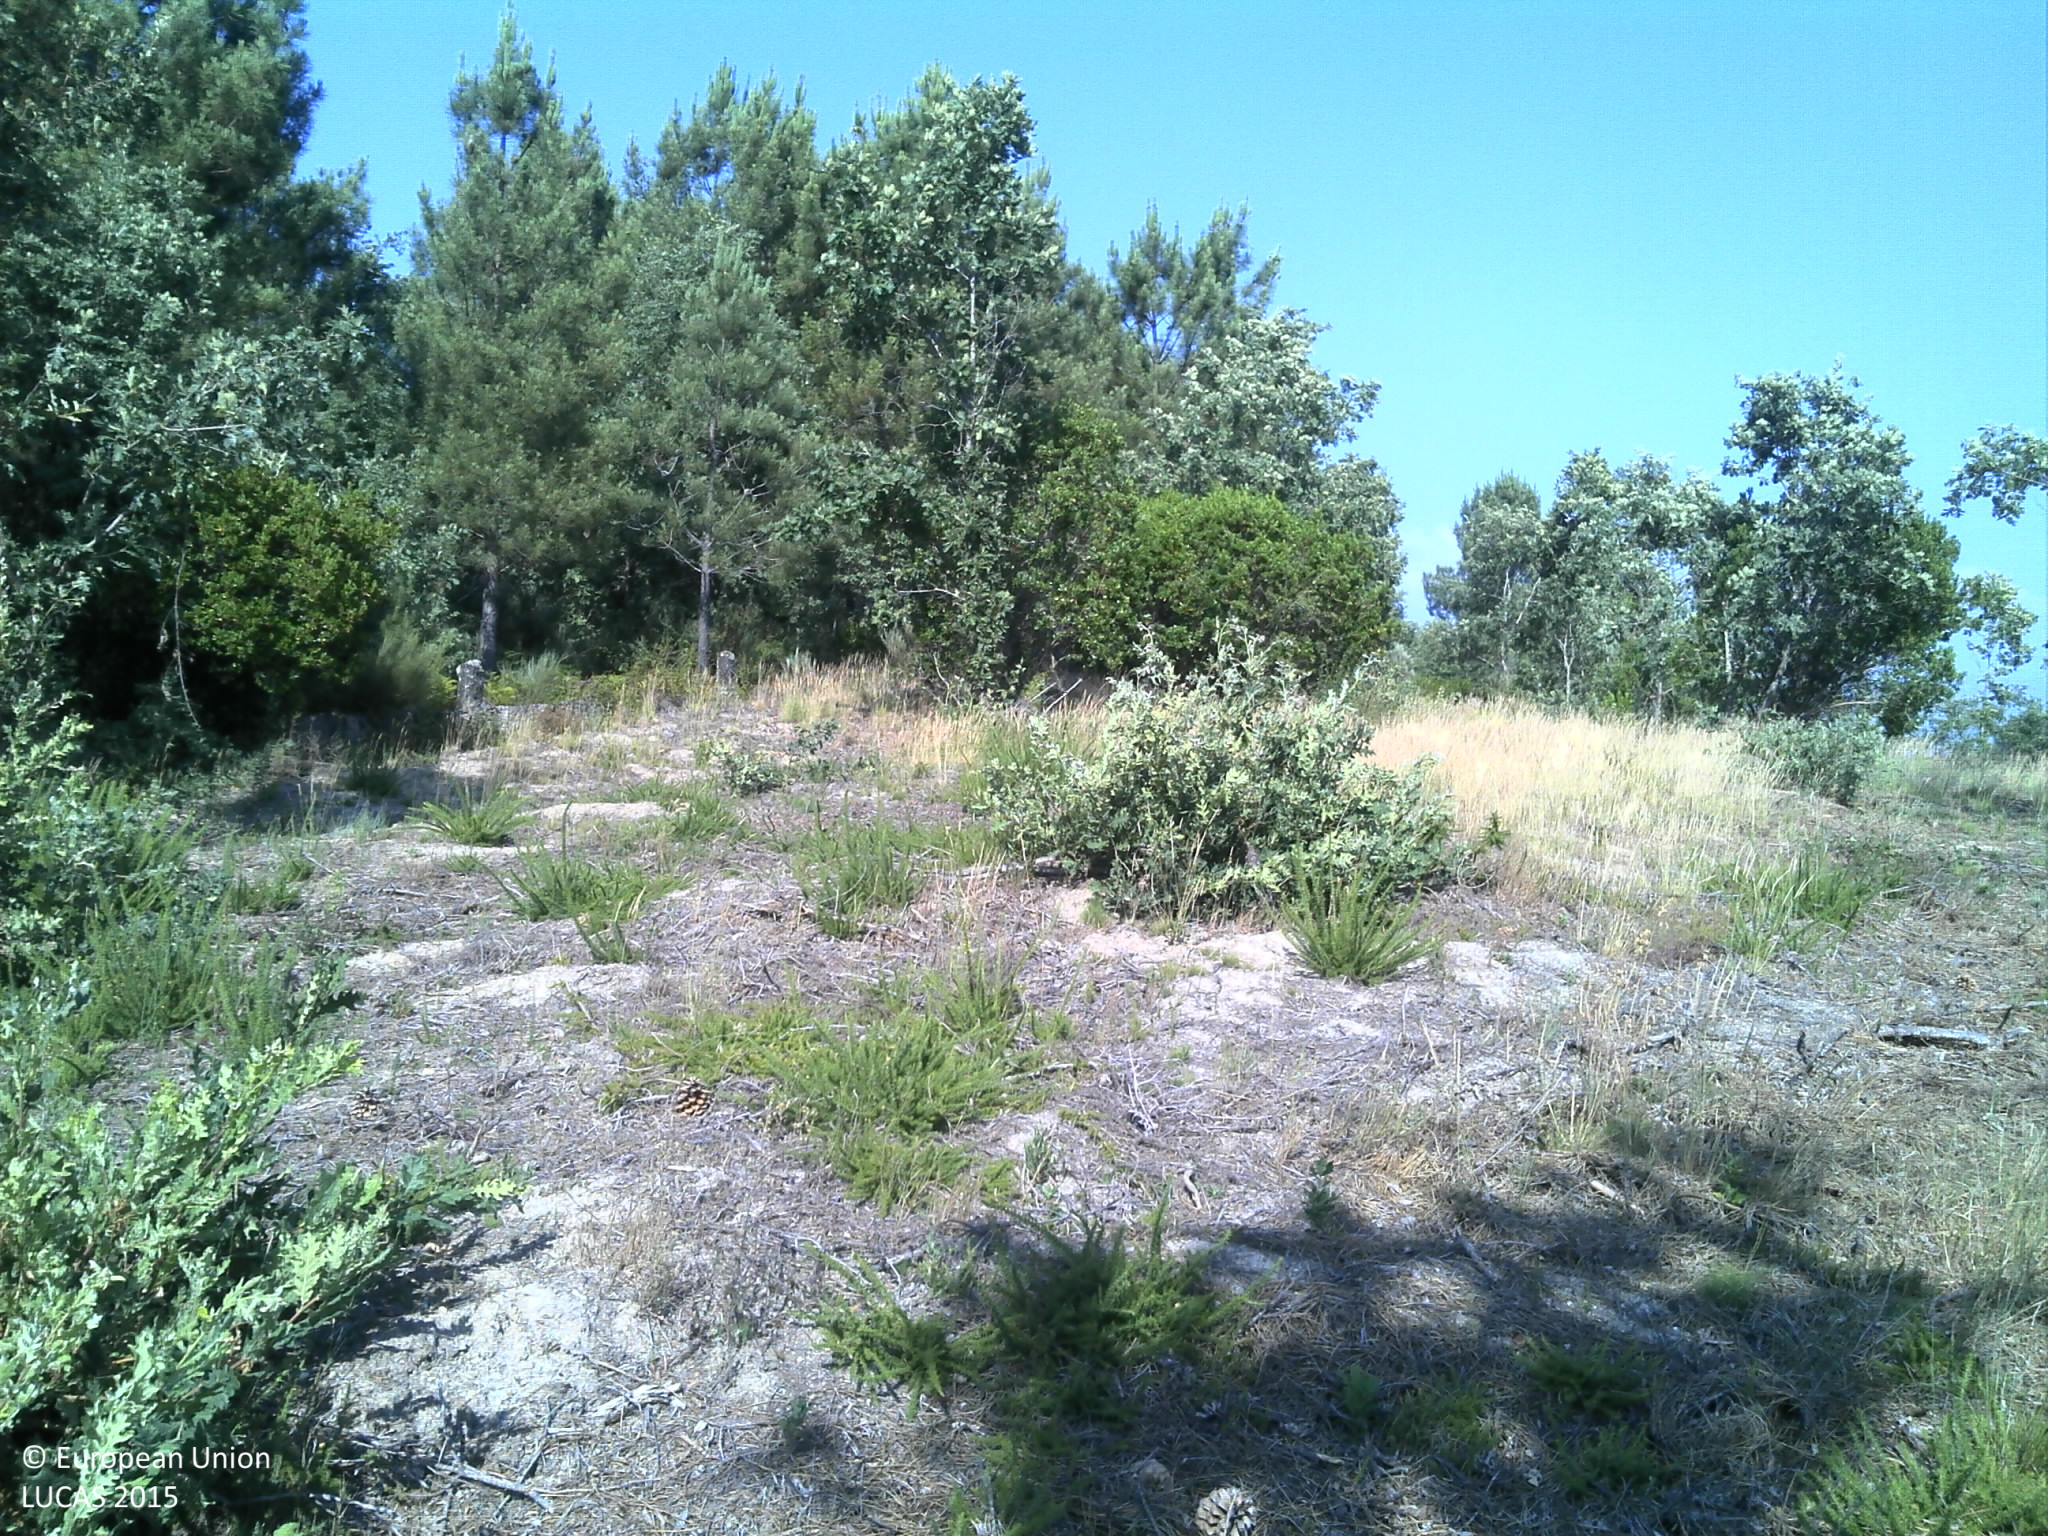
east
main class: Shrubland
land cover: Shrubland with sparse tree cover
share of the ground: 50 - 75 %
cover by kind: shrubs 60 %, herbaceous plants 30 %, broadleaved forest trees 5 %, unconsolidated bare surface 5 %
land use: Forestry
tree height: > 5 m
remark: Clear cut
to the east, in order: Shrubland with sparse tree cover; Shrubland without tree cover; Shrubland with sparse tree cover; Dry stone walls; Grass margins; Tracks; Grass margins; Dry stone walls; Pine dominated mixed woodland; Broadleaved woodland; Shrubland with sparse tree cover; Broadleaved woodland; Shrubland without tree cover; Broadleaved woodland
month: June
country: PT
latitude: 40.4151
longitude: -7.8066
